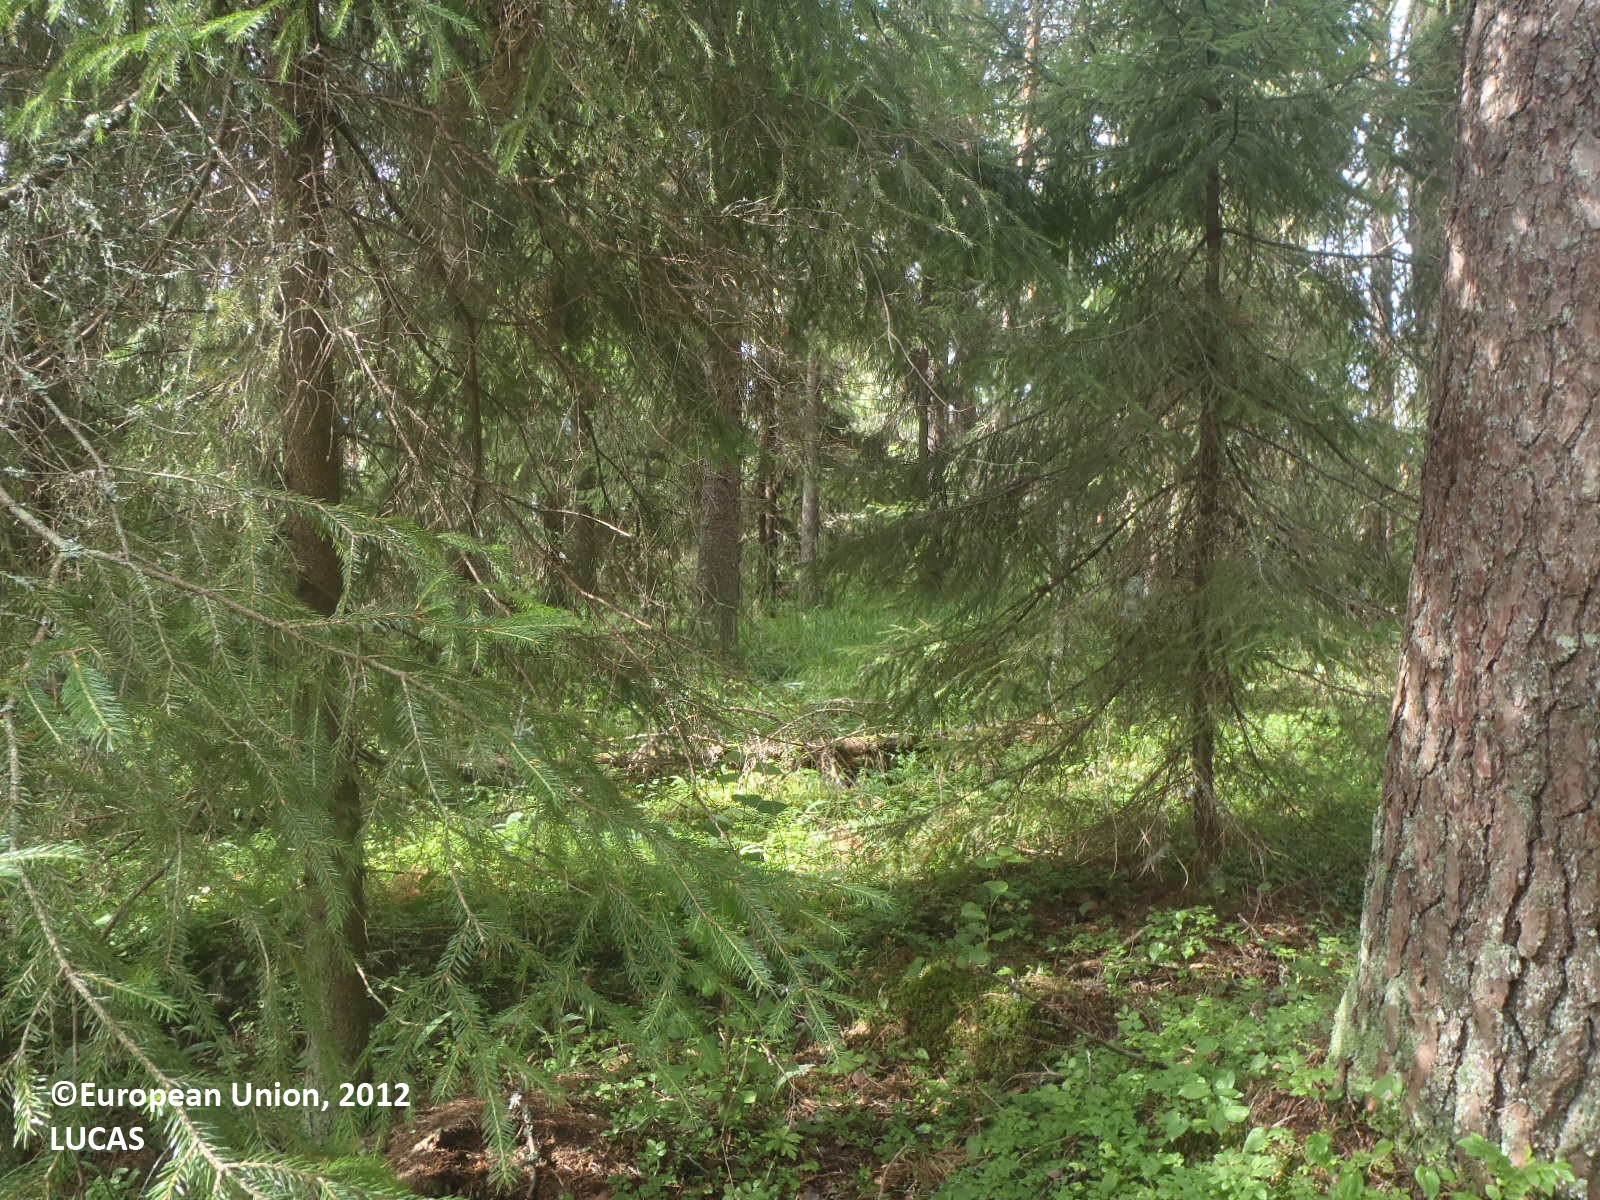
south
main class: Woodland
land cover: Other coniferous woodland
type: boreal forest
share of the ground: 50 - 75 %
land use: Forestry
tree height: > 5 m
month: July
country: FI
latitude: 61.0969
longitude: 21.9099
